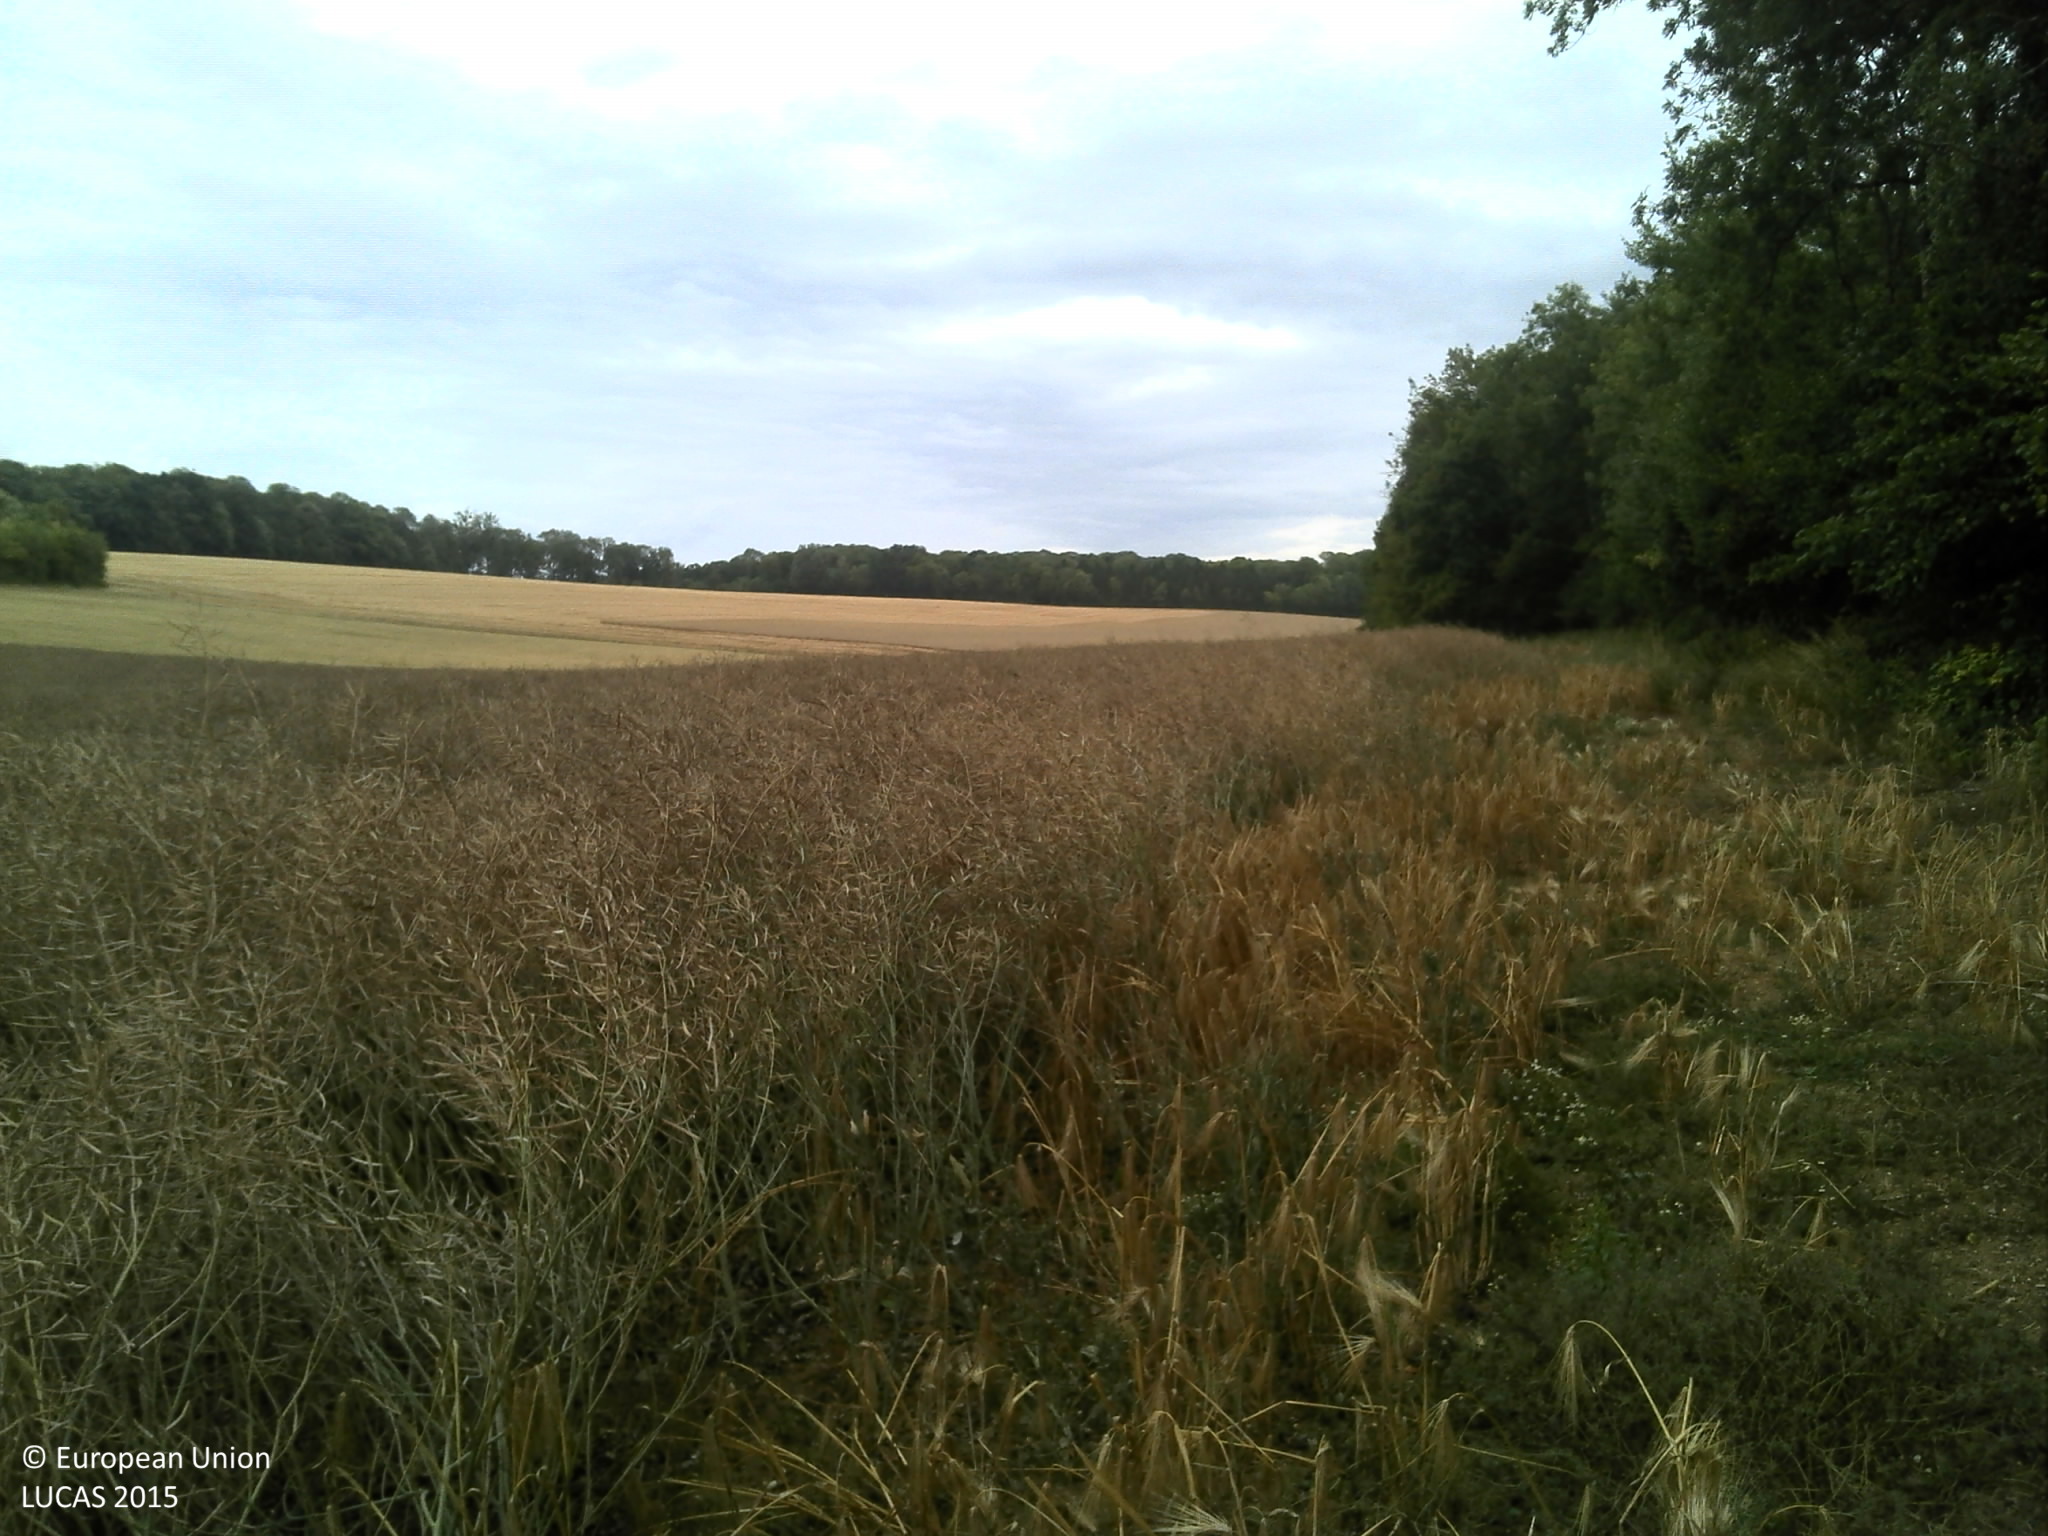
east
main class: Cropland
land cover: Rape and turnip rape
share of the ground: > 75 %
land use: Agriculture (excluding fallow land and kitchen gardens)
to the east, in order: Rape and turnip rape; Grassland without tree/shrub cover; Tracks; Common wheat
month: July
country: FR
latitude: 49.5472
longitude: 4.1487
